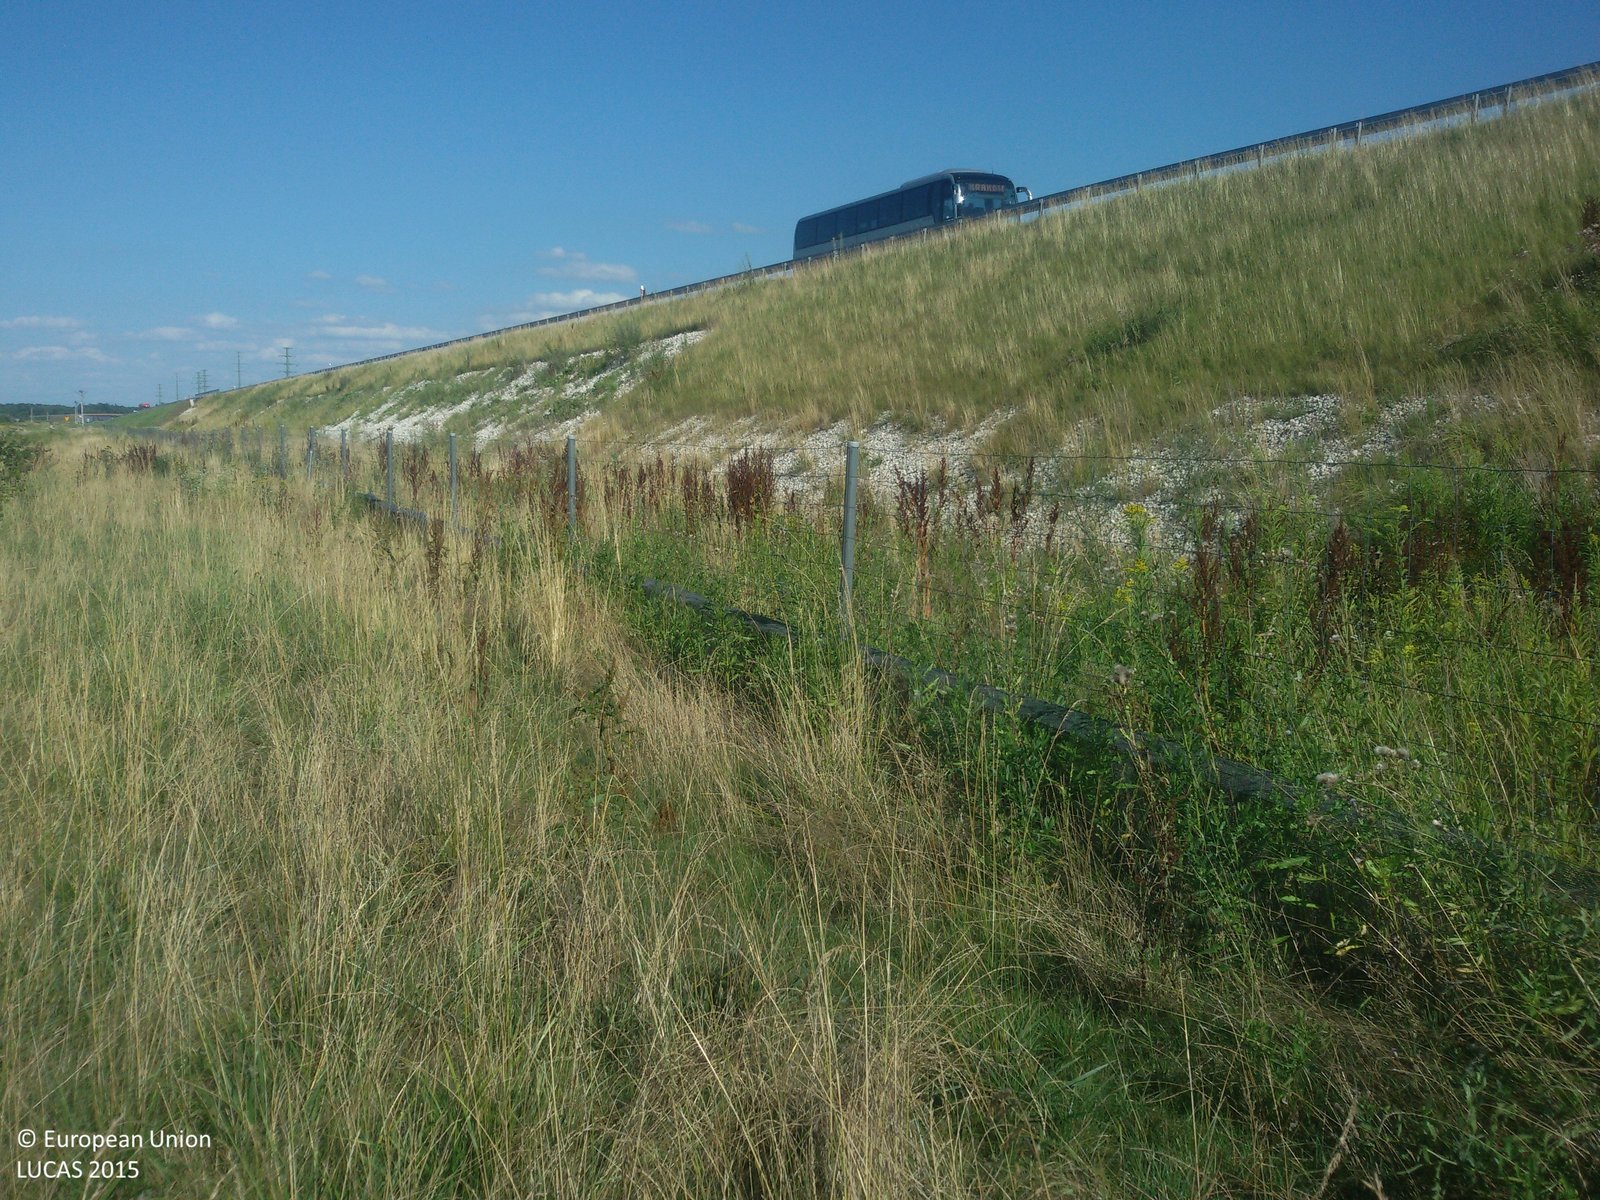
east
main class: Grassland
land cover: Grassland without tree/shrub cover
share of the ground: > 75 %
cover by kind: herbaceous plants 100 %
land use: Road transport
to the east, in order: Grassland without tree/shrub cover; Fences; Grassland without tree/shrub cover; Paved roads, cycling and walking lanes
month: July
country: PL
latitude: 50.0044
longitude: 20.7137
